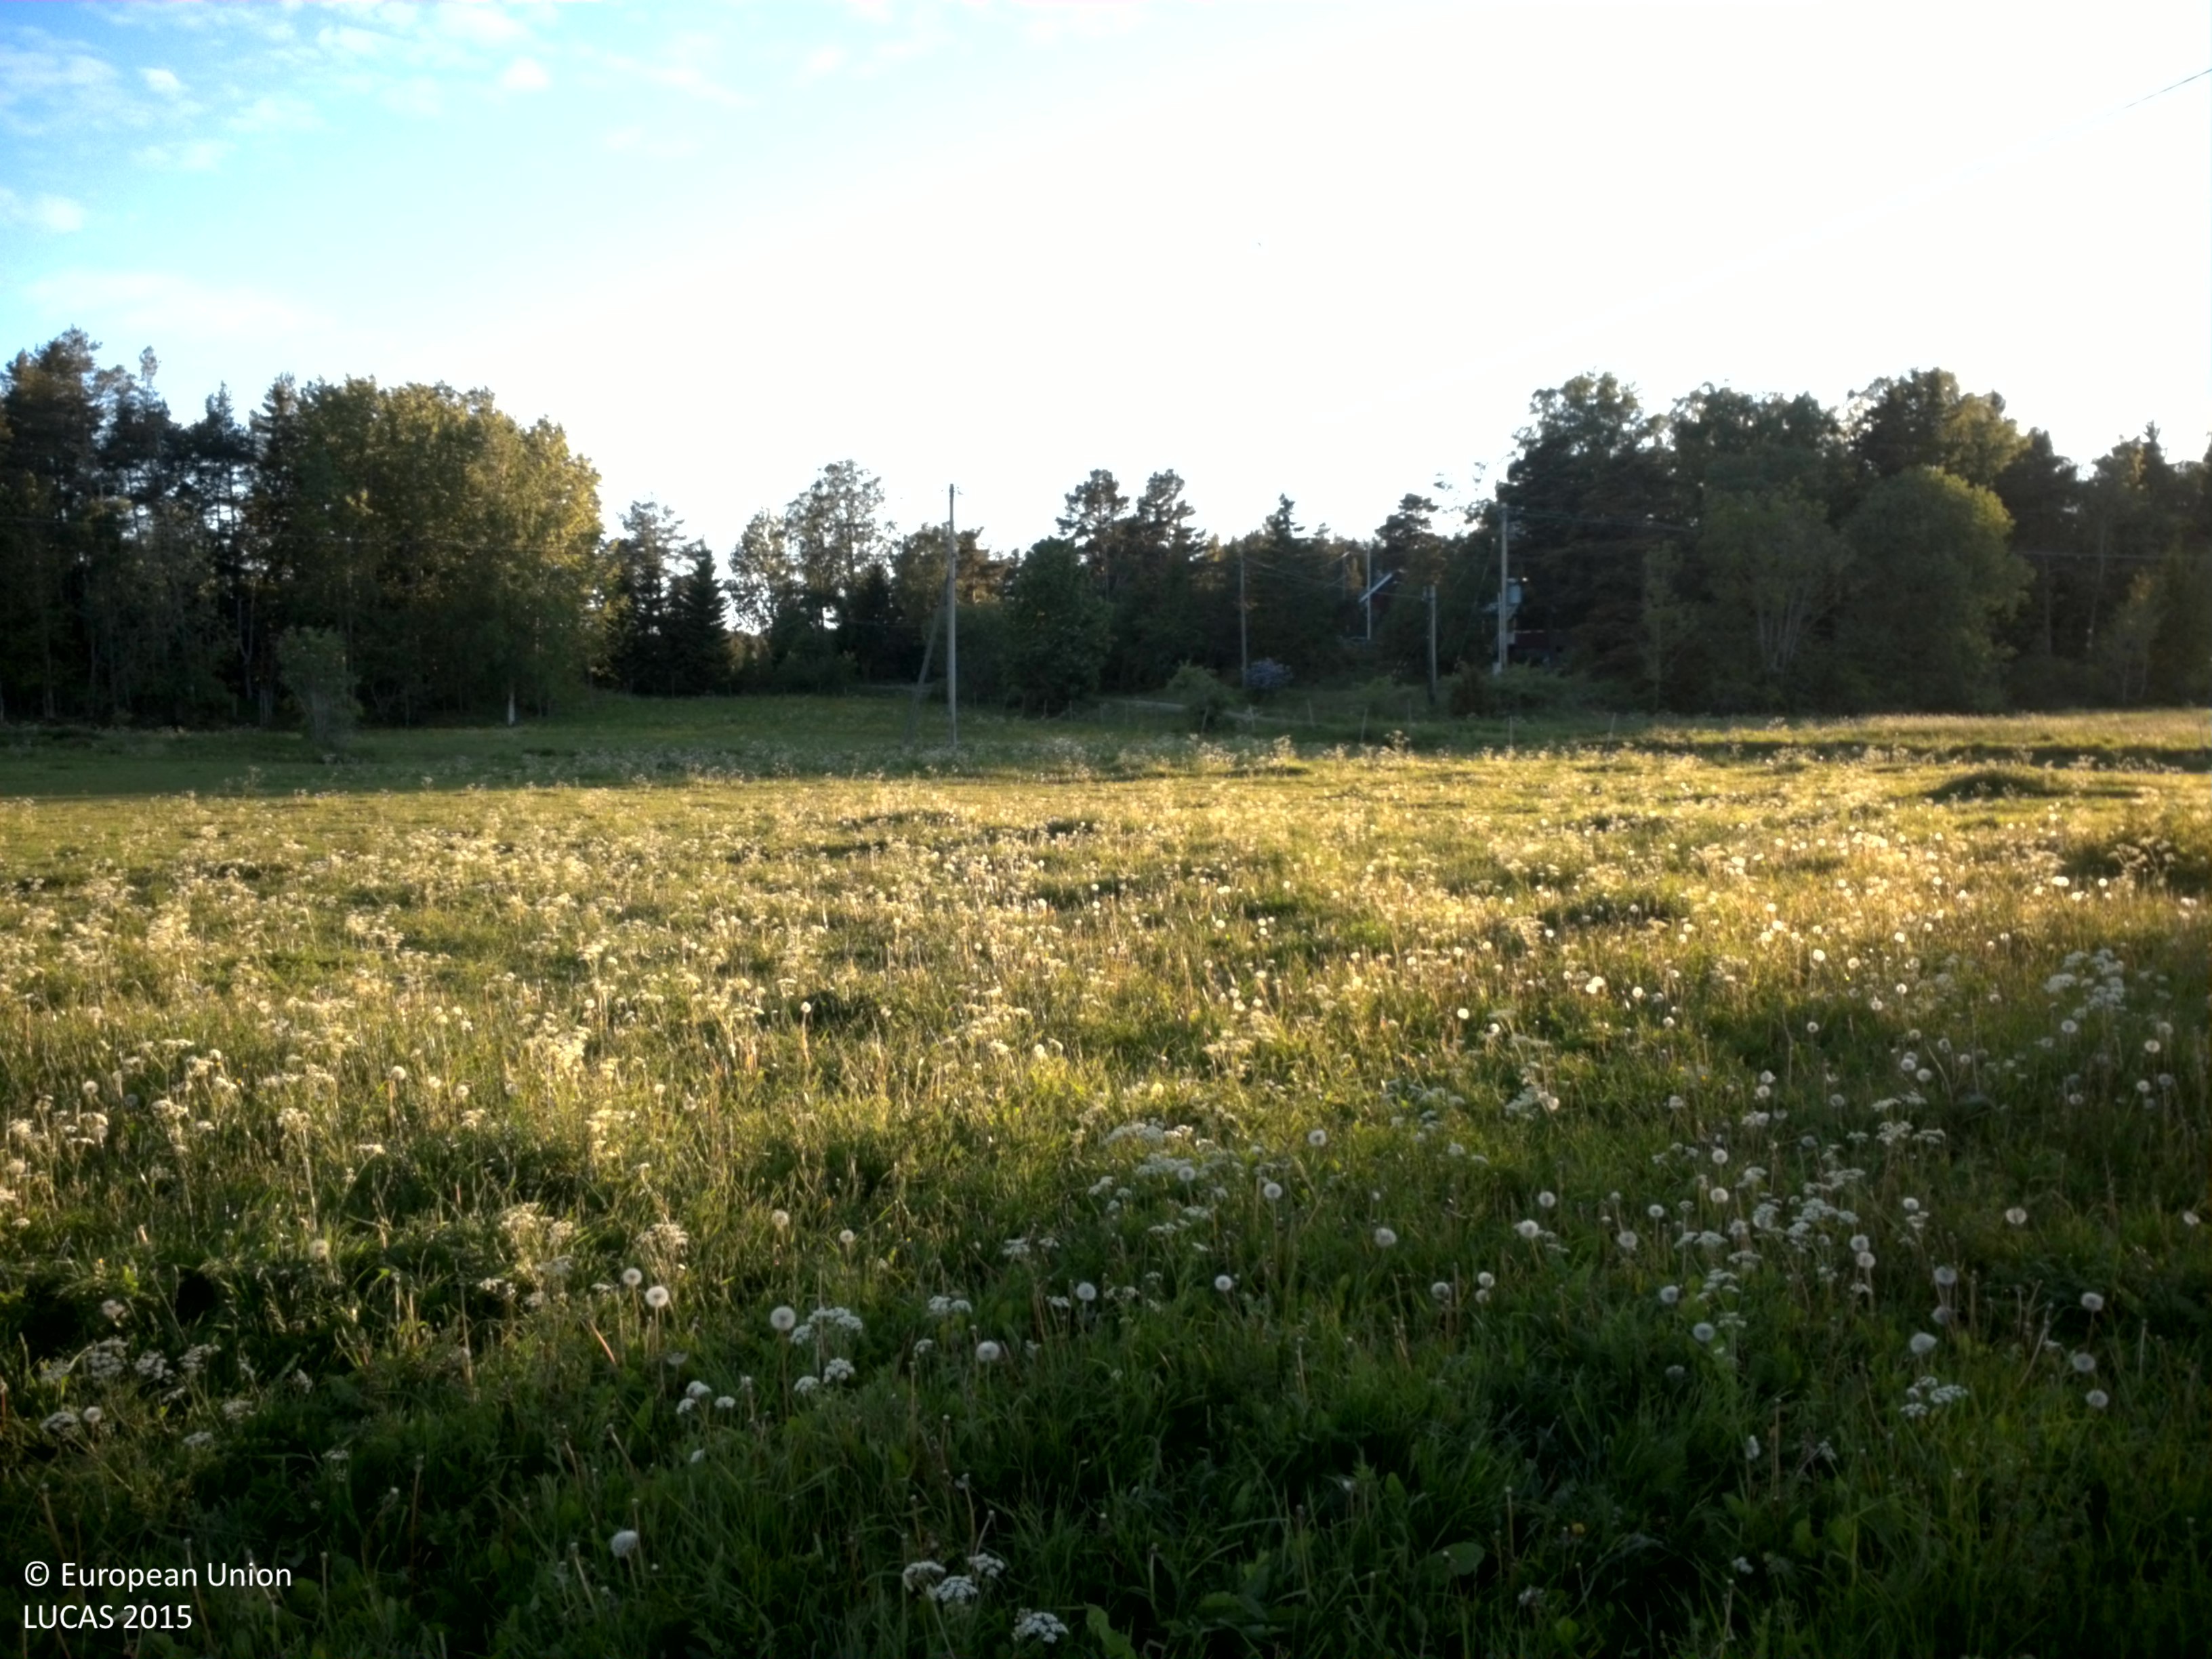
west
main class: Grassland
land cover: Grassland without tree/shrub cover
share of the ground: > 75 %
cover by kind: herbaceous plants 85 %, lichens and mosses 10 %, shrubs 5 %
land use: Agriculture (excluding fallow land and kitchen gardens)
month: June
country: SE
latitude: 60.1609
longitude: 18.7729
